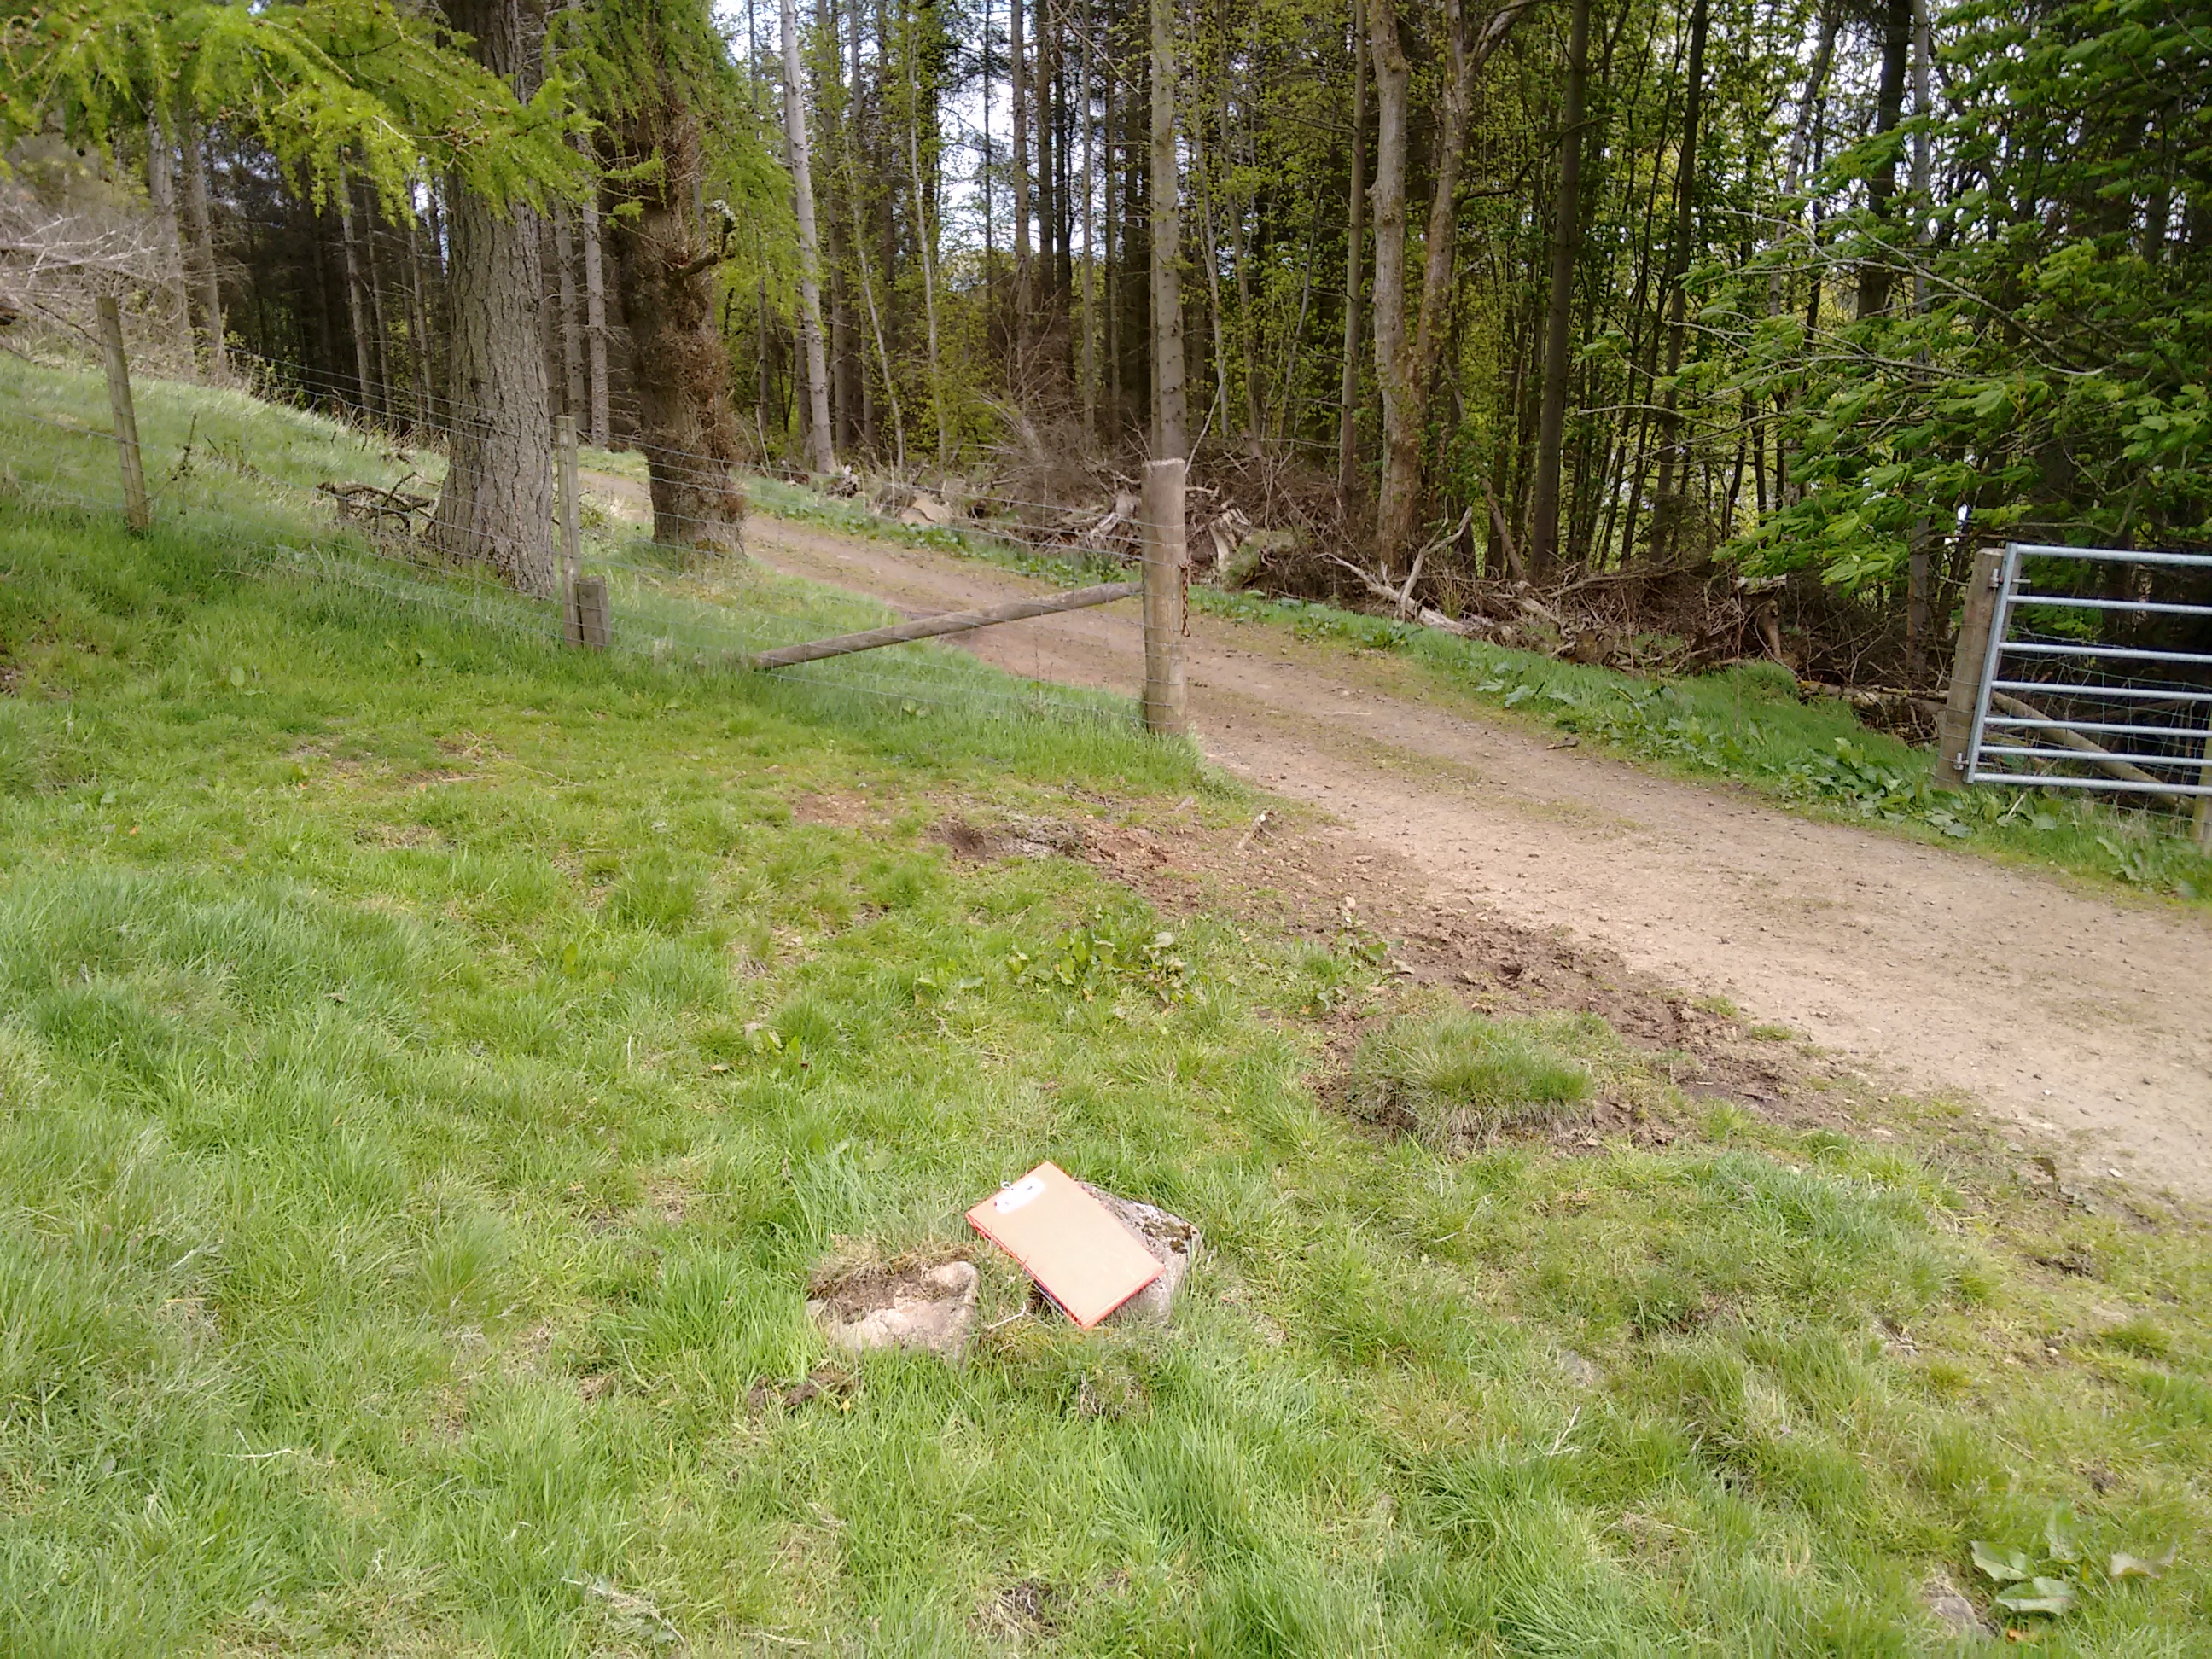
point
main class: Grassland
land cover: Grassland without tree/shrub cover
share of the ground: > 75 %
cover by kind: herbaceous plants 100 %
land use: Agriculture (excluding fallow land and kitchen gardens)
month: May
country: GB
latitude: 55.9476
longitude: -3.6432
